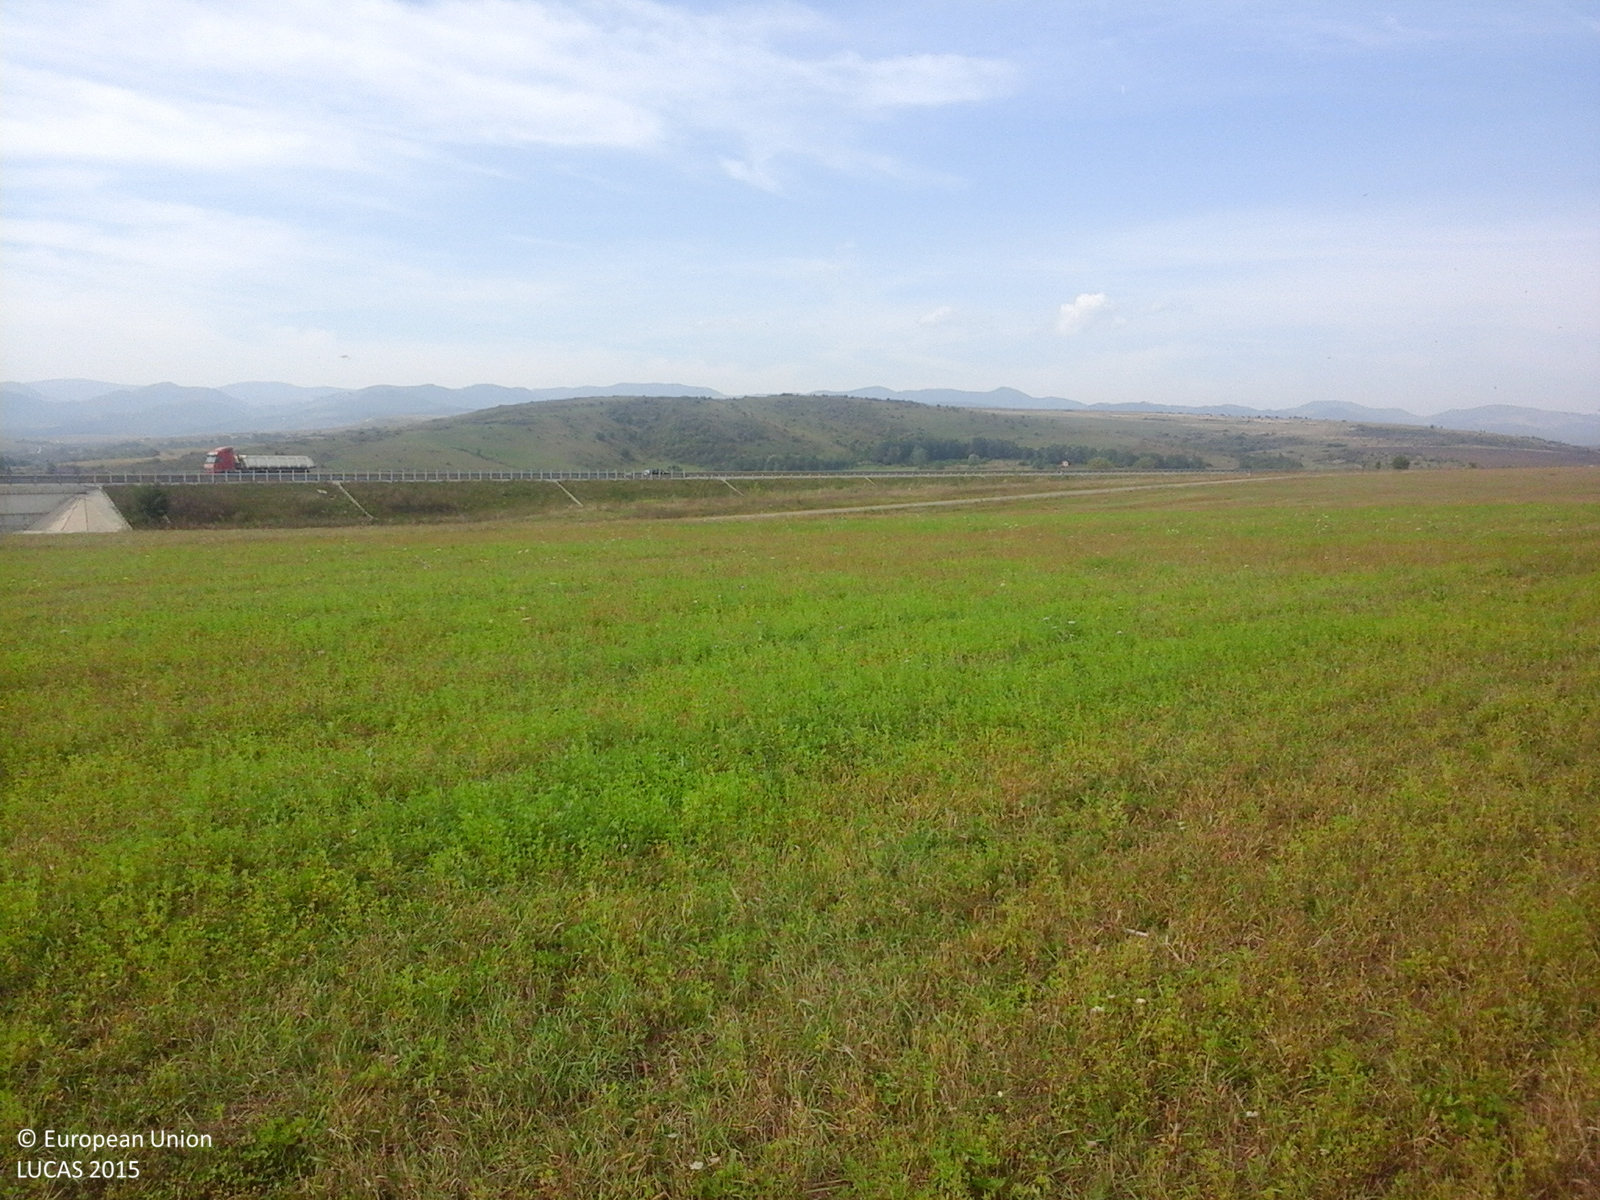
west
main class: Cropland
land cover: Lucerne
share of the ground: > 75 %
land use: Agriculture (excluding fallow land and kitchen gardens)
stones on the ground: < 10 %
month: September
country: RO
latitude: 46.6357
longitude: 23.5369
